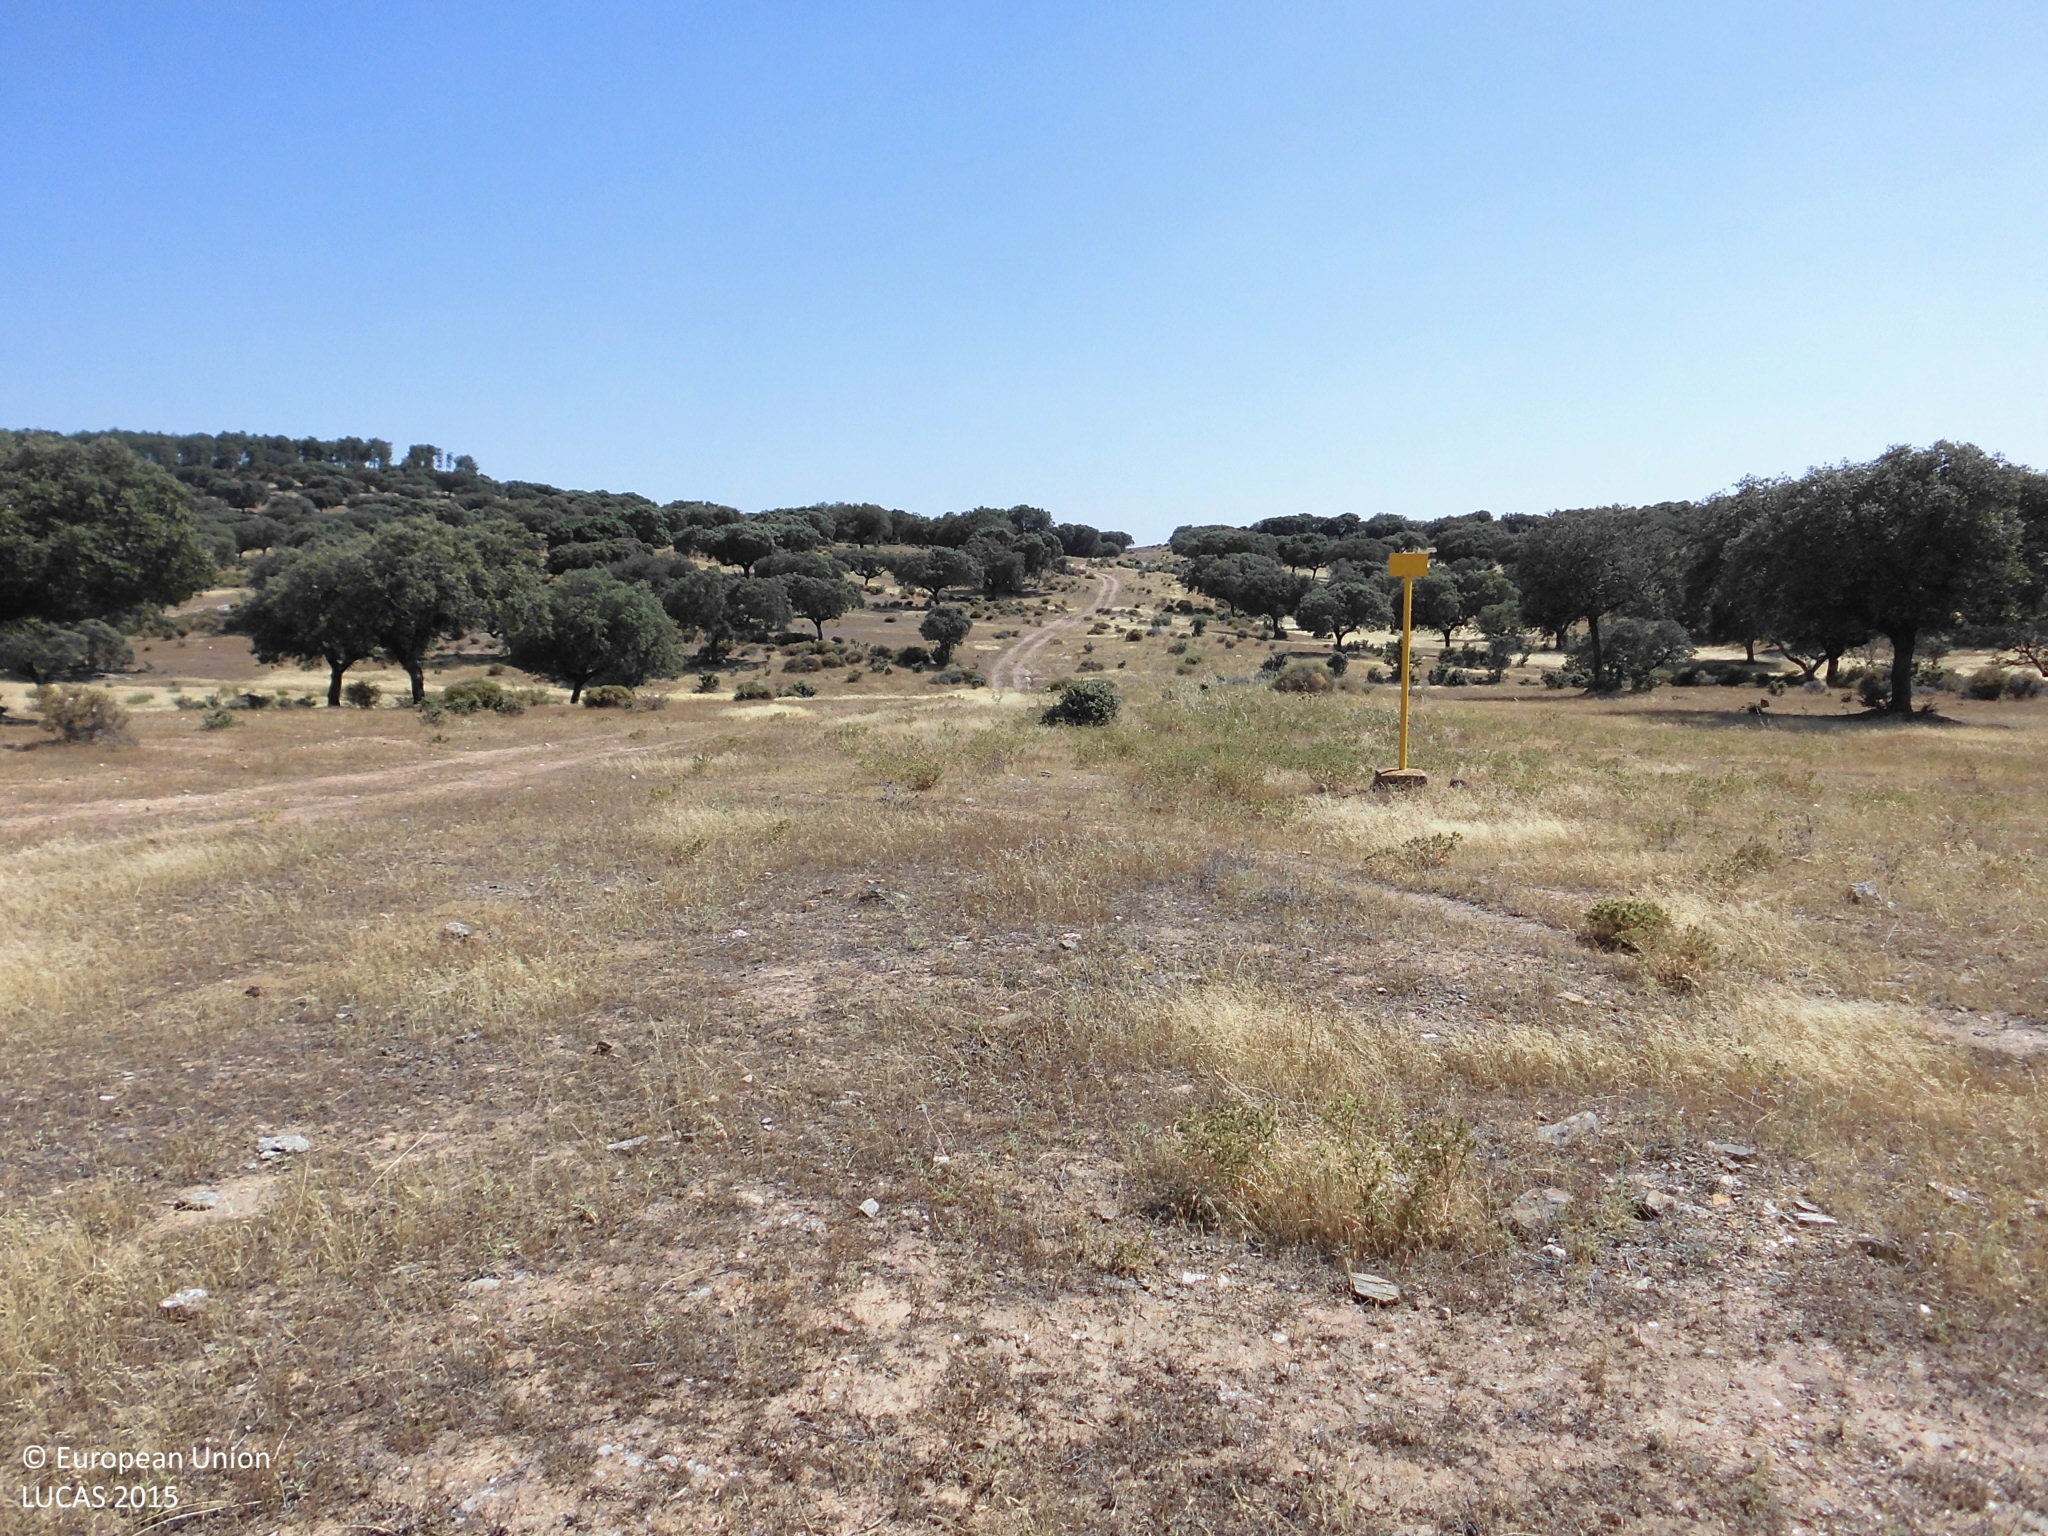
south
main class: Woodland
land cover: Broadleaved woodland
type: broadleaved evergreen forest
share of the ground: 10 - 25 %
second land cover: Grassland without tree/shrub cover
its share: > 75 %
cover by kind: herbaceous plants 90 %, broadleaved forest trees 10 %
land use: Forestry
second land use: Agriculture (excluding fallow land and kitchen gardens)
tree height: > 5 m
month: June
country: ES
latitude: 39.7496
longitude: -6.1386
